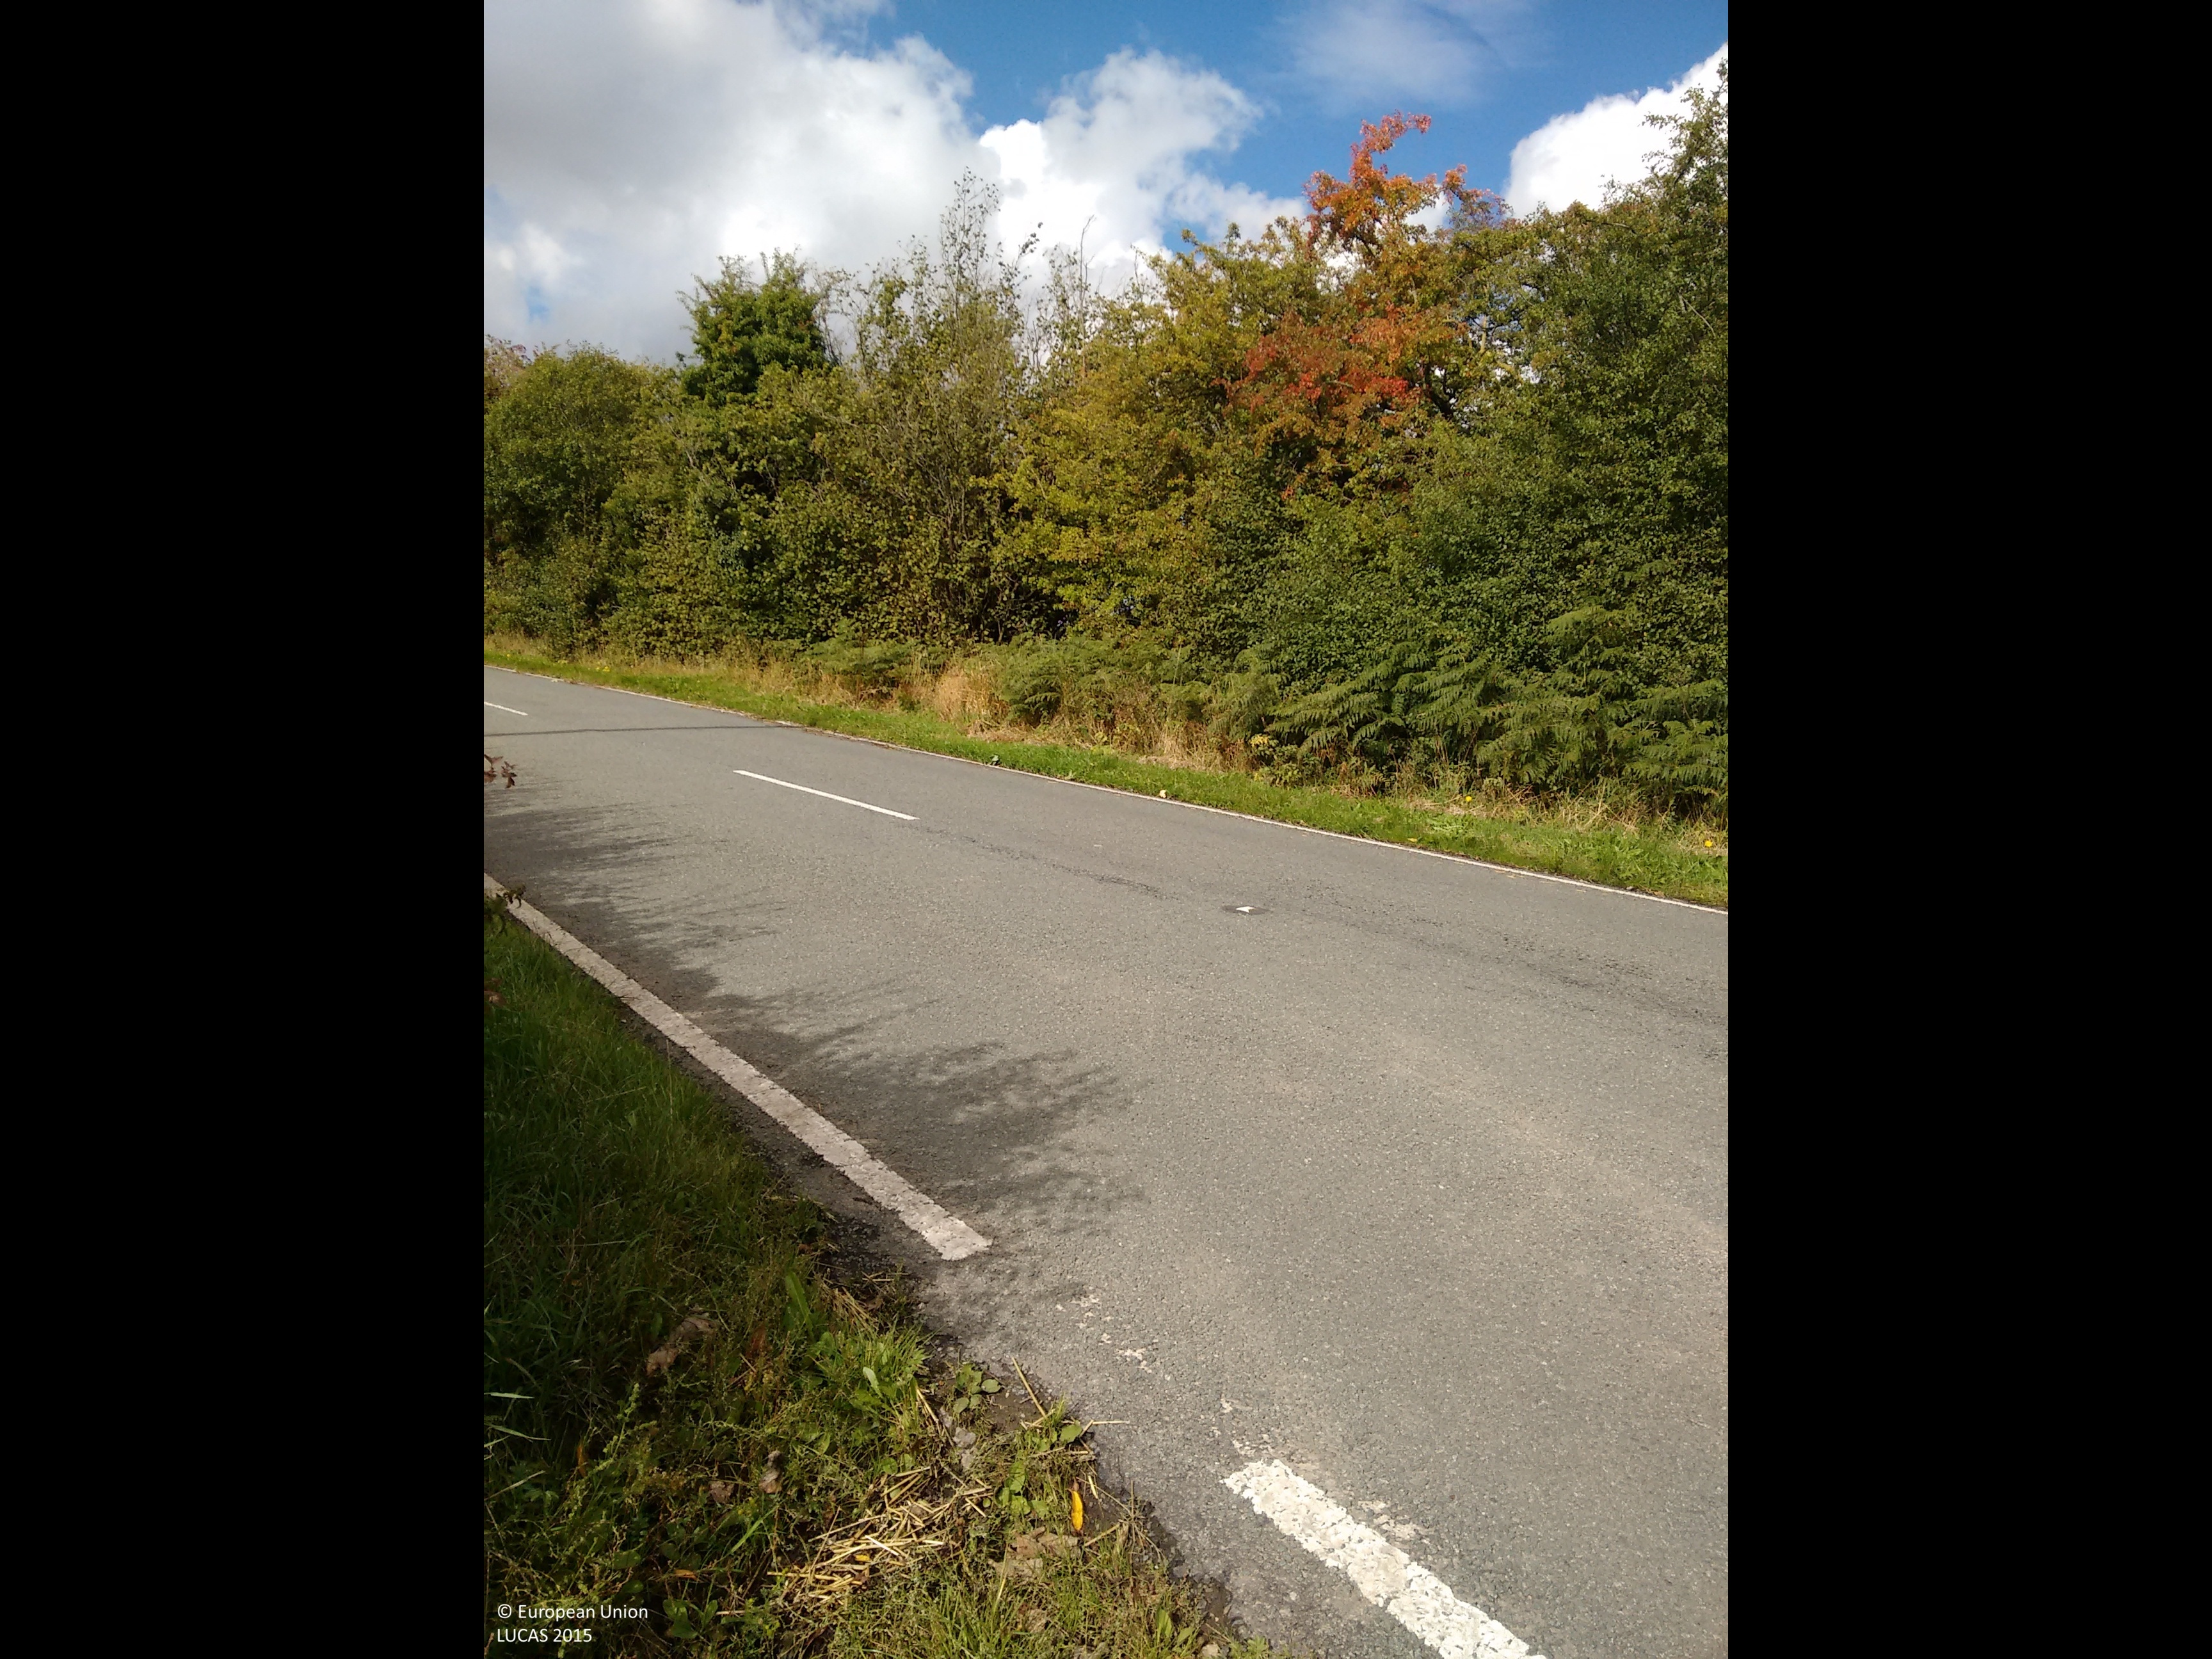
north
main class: Woodland
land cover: Broadleaved woodland
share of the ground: > 75 %
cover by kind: broadleaved forest trees 90 %, shrubs 10 %
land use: Agriculture (excluding fallow land and kitchen gardens)
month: September
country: GB
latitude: 53.1069
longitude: -3.0868
